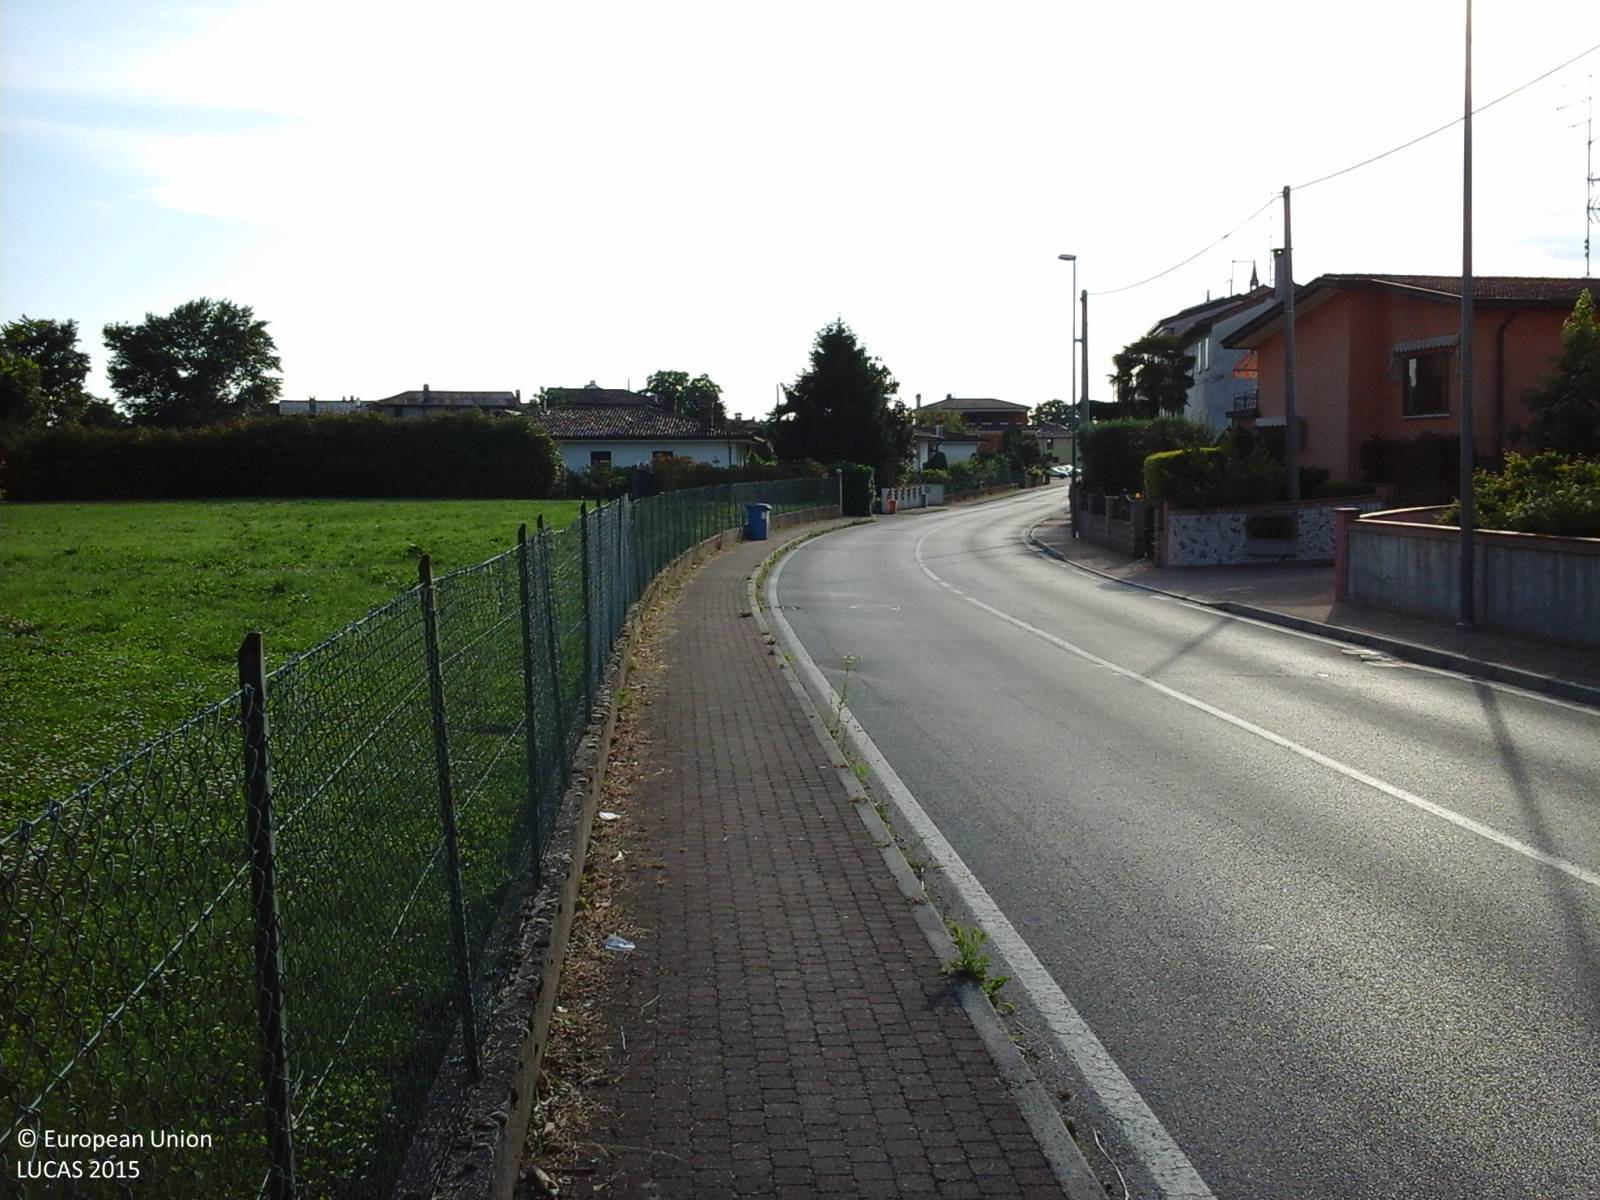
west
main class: Woodland
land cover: Broadleaved woodland
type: non-riverine alder, birch or aspen forest
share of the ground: > 75 %
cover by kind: broadleaved forest trees 100 %
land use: Residential
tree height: > 5 m
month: June
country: IT
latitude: 45.8488
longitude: 12.6878
